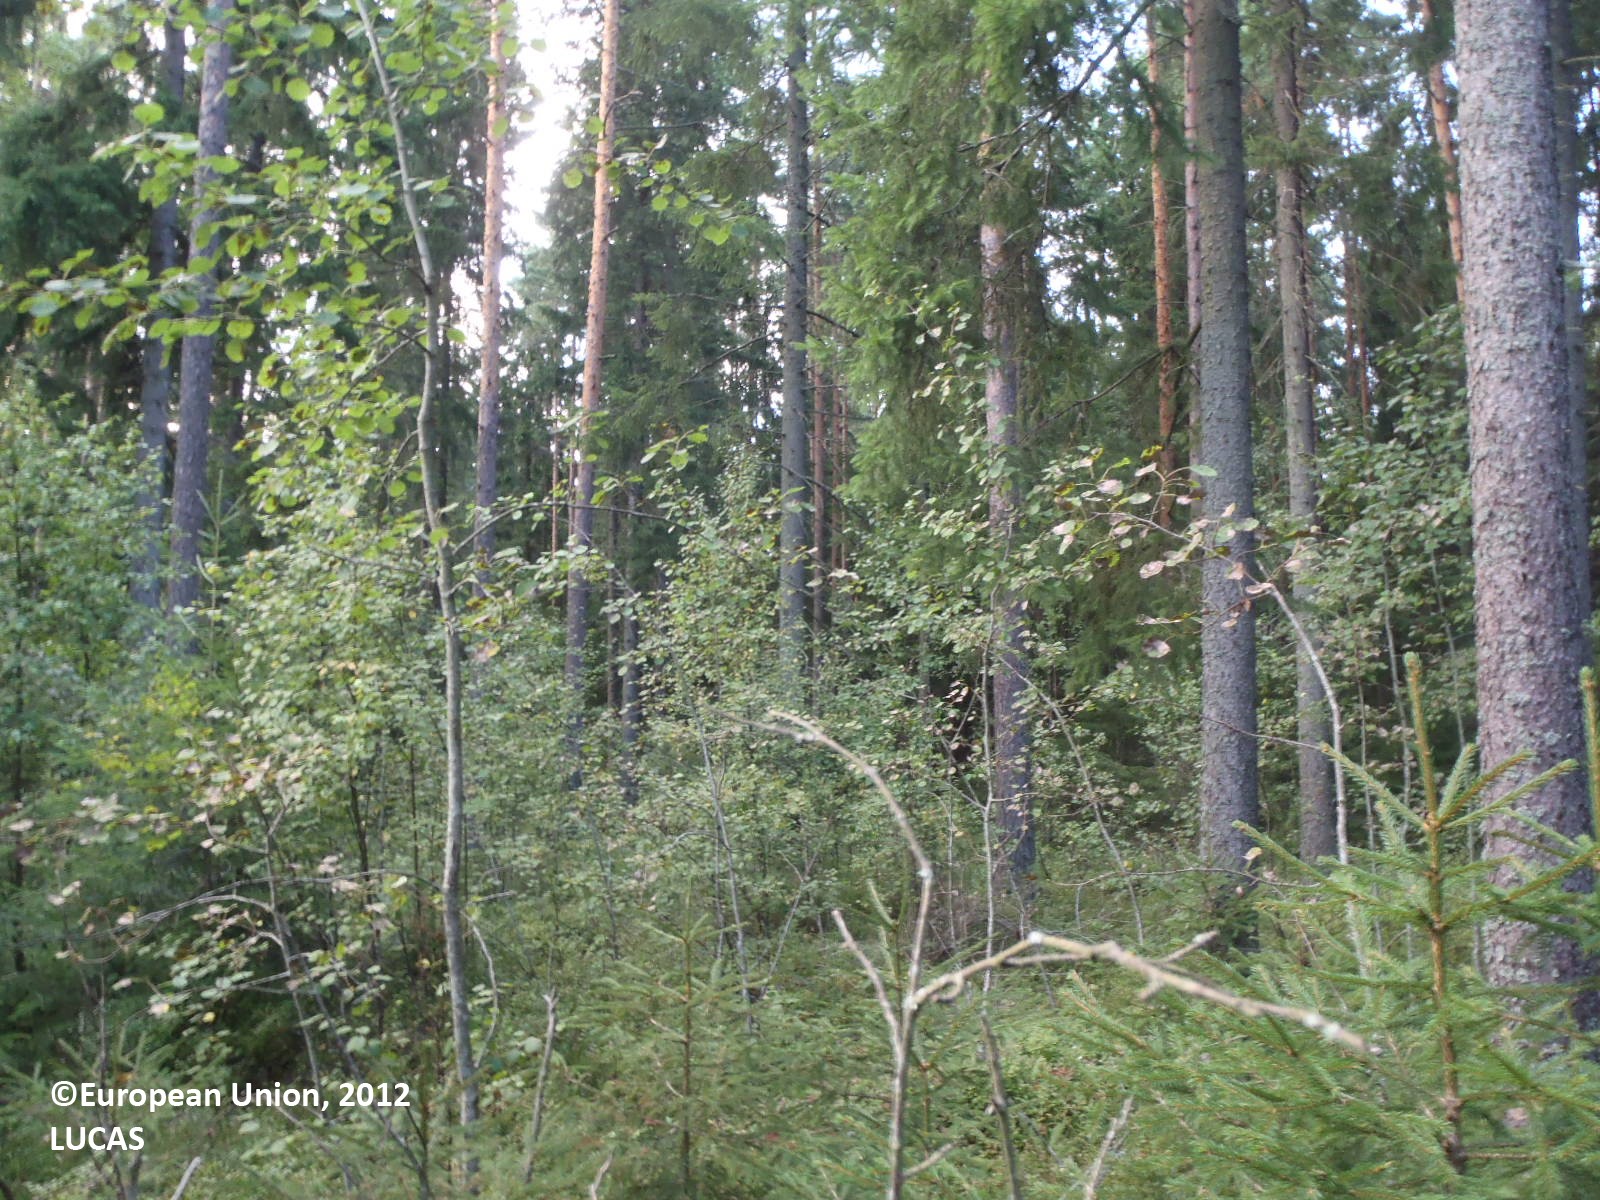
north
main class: Woodland
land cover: Other coniferous woodland
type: boreal forest
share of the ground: > 75 %
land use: Forestry
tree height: > 5 m
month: August
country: FI
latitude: 60.6023
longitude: 22.3585
